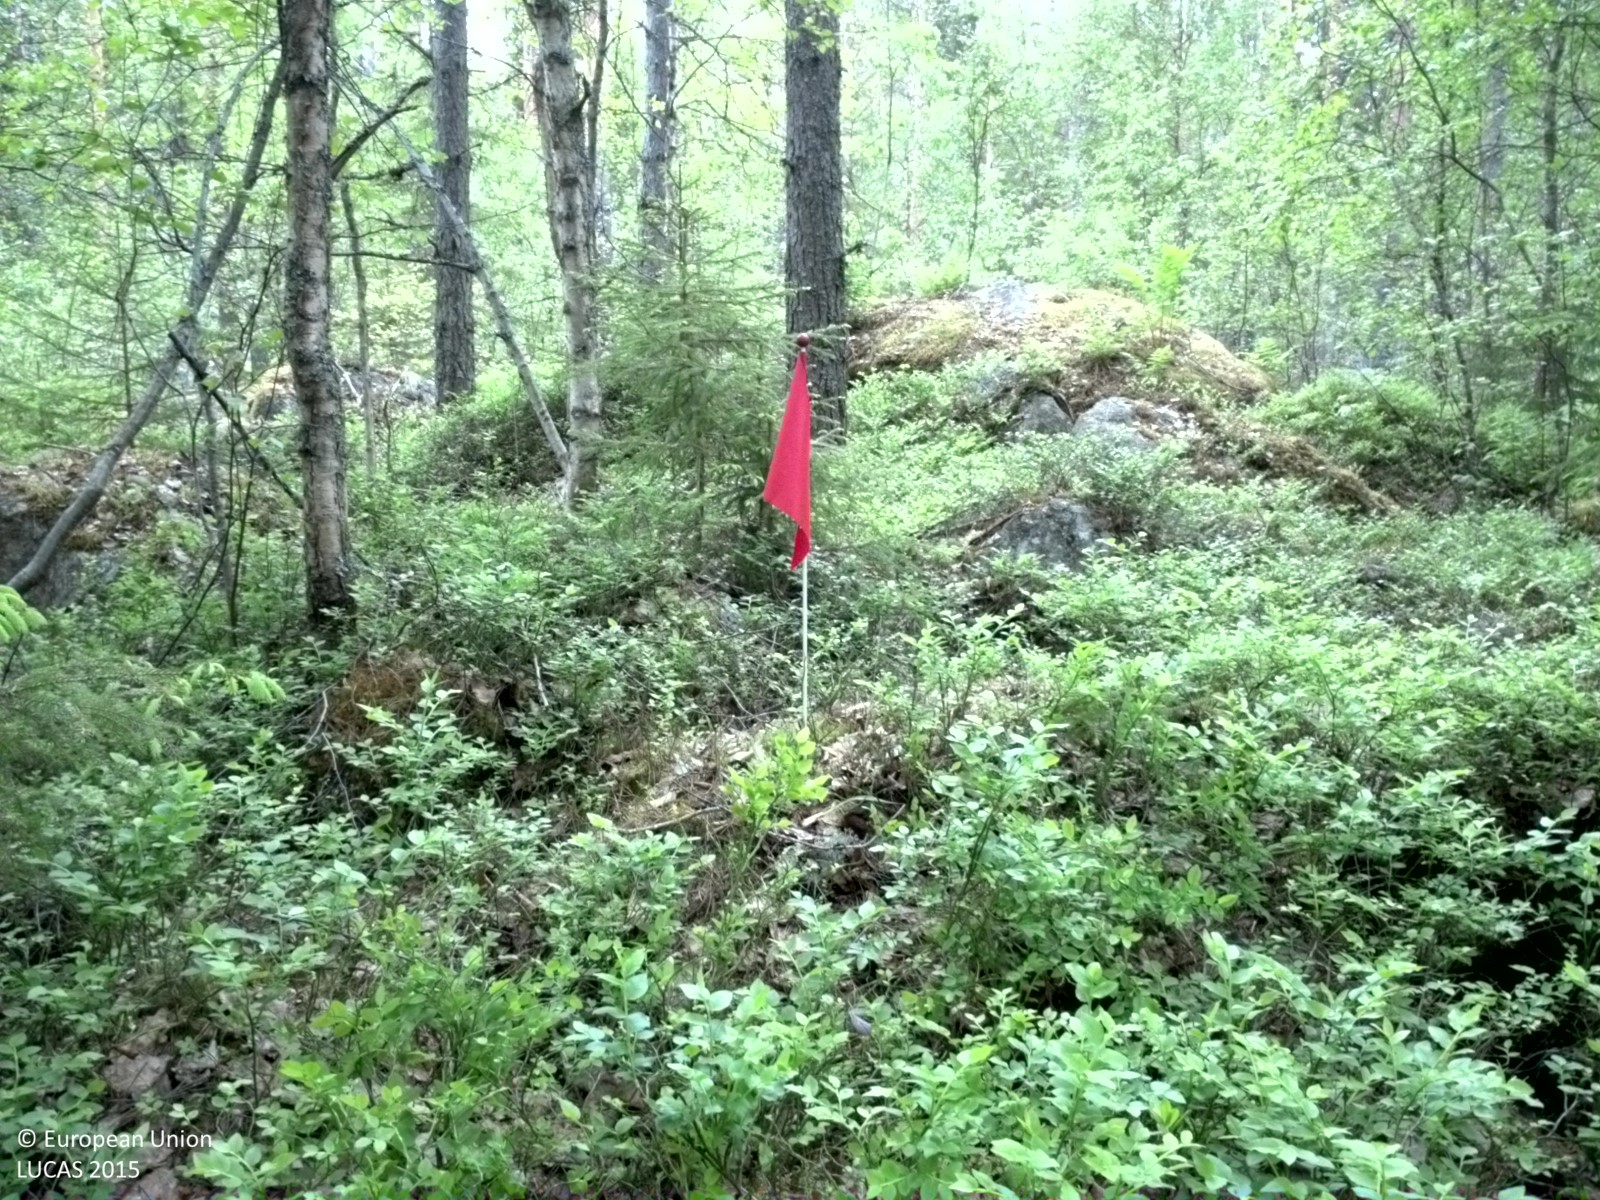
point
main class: Woodland
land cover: Pine dominated mixed woodland
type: boreal forest
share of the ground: 50 - 75 %
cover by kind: coniferous forest trees 40 %, broadleaved forest trees 35 %, shrubs 10 %, herbaceous plants 5 %, lichens and mosses 5 %, consolidated bare surface 5 %
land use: Forestry
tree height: > 5 m
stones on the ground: < 10 %
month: June
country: SE
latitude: 60.3518
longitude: 17.3308
